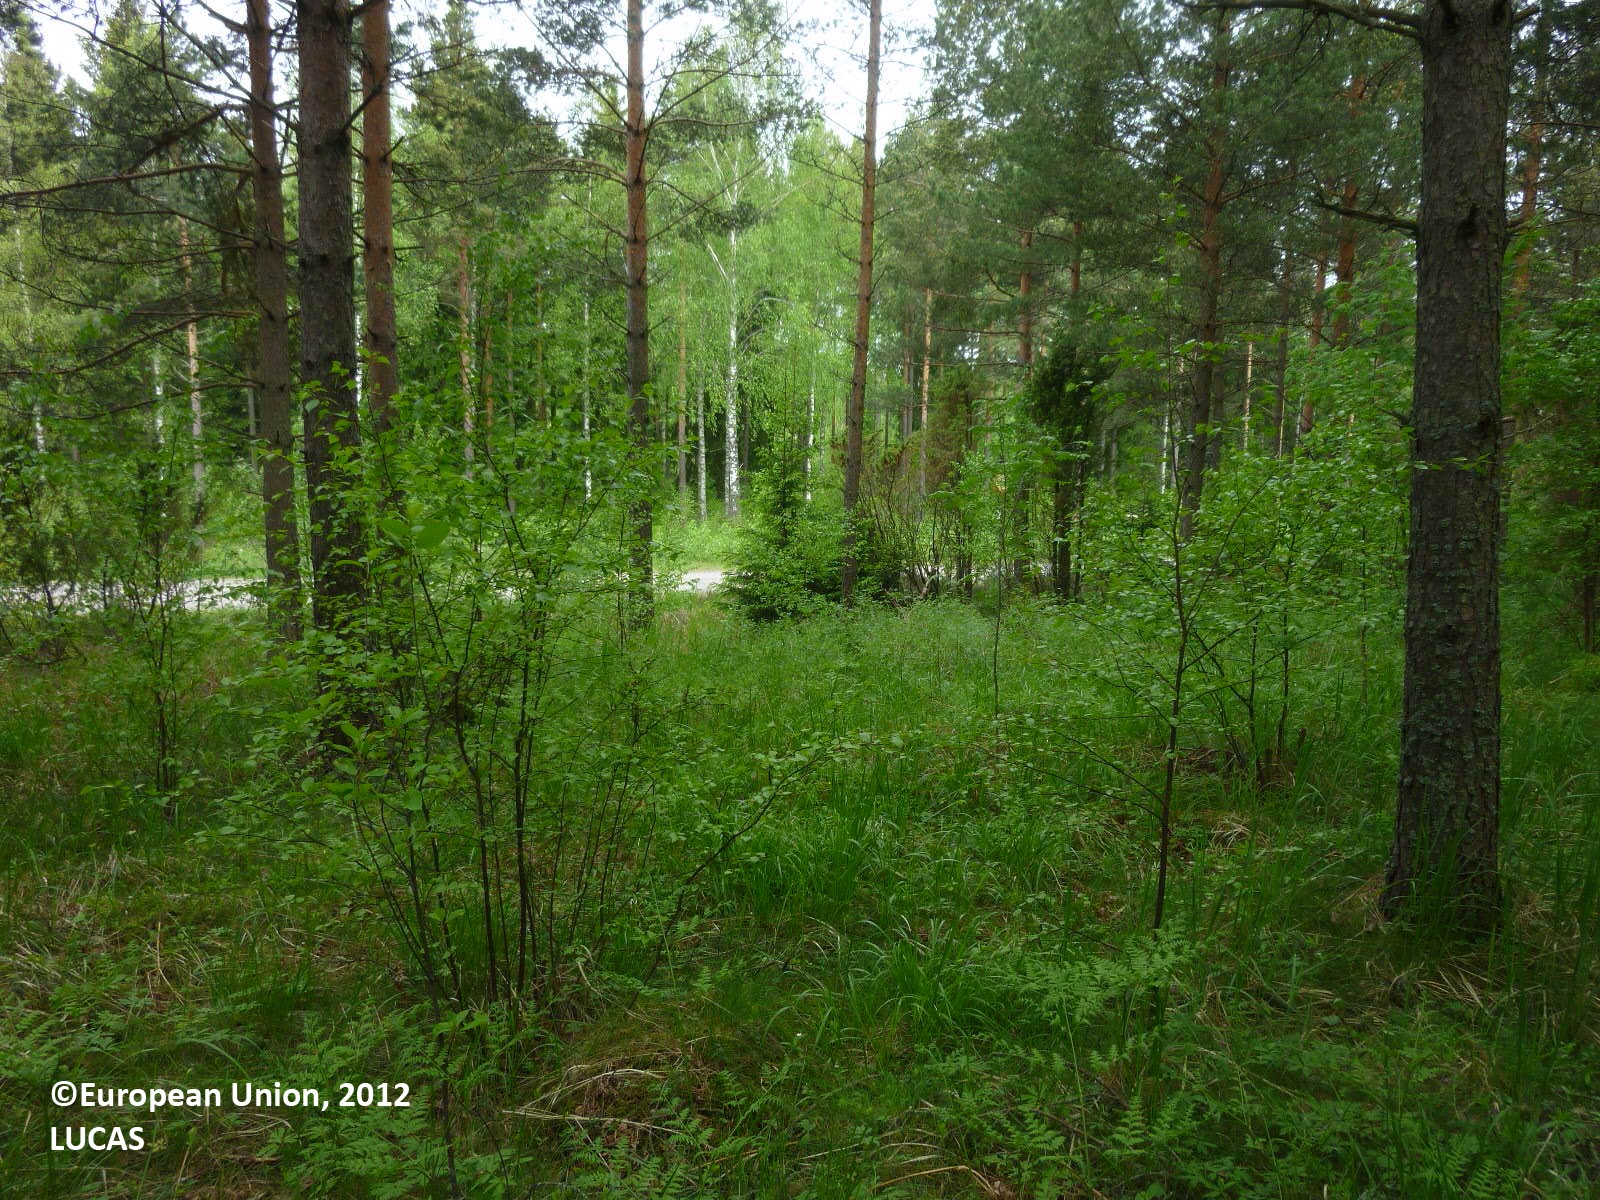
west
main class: Woodland
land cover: Pine dominated coniferous woodland
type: boreal forest
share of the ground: 50 - 75 %
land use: Forestry
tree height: > 5 m
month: June
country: FI
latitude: 60.4260
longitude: 22.6978
